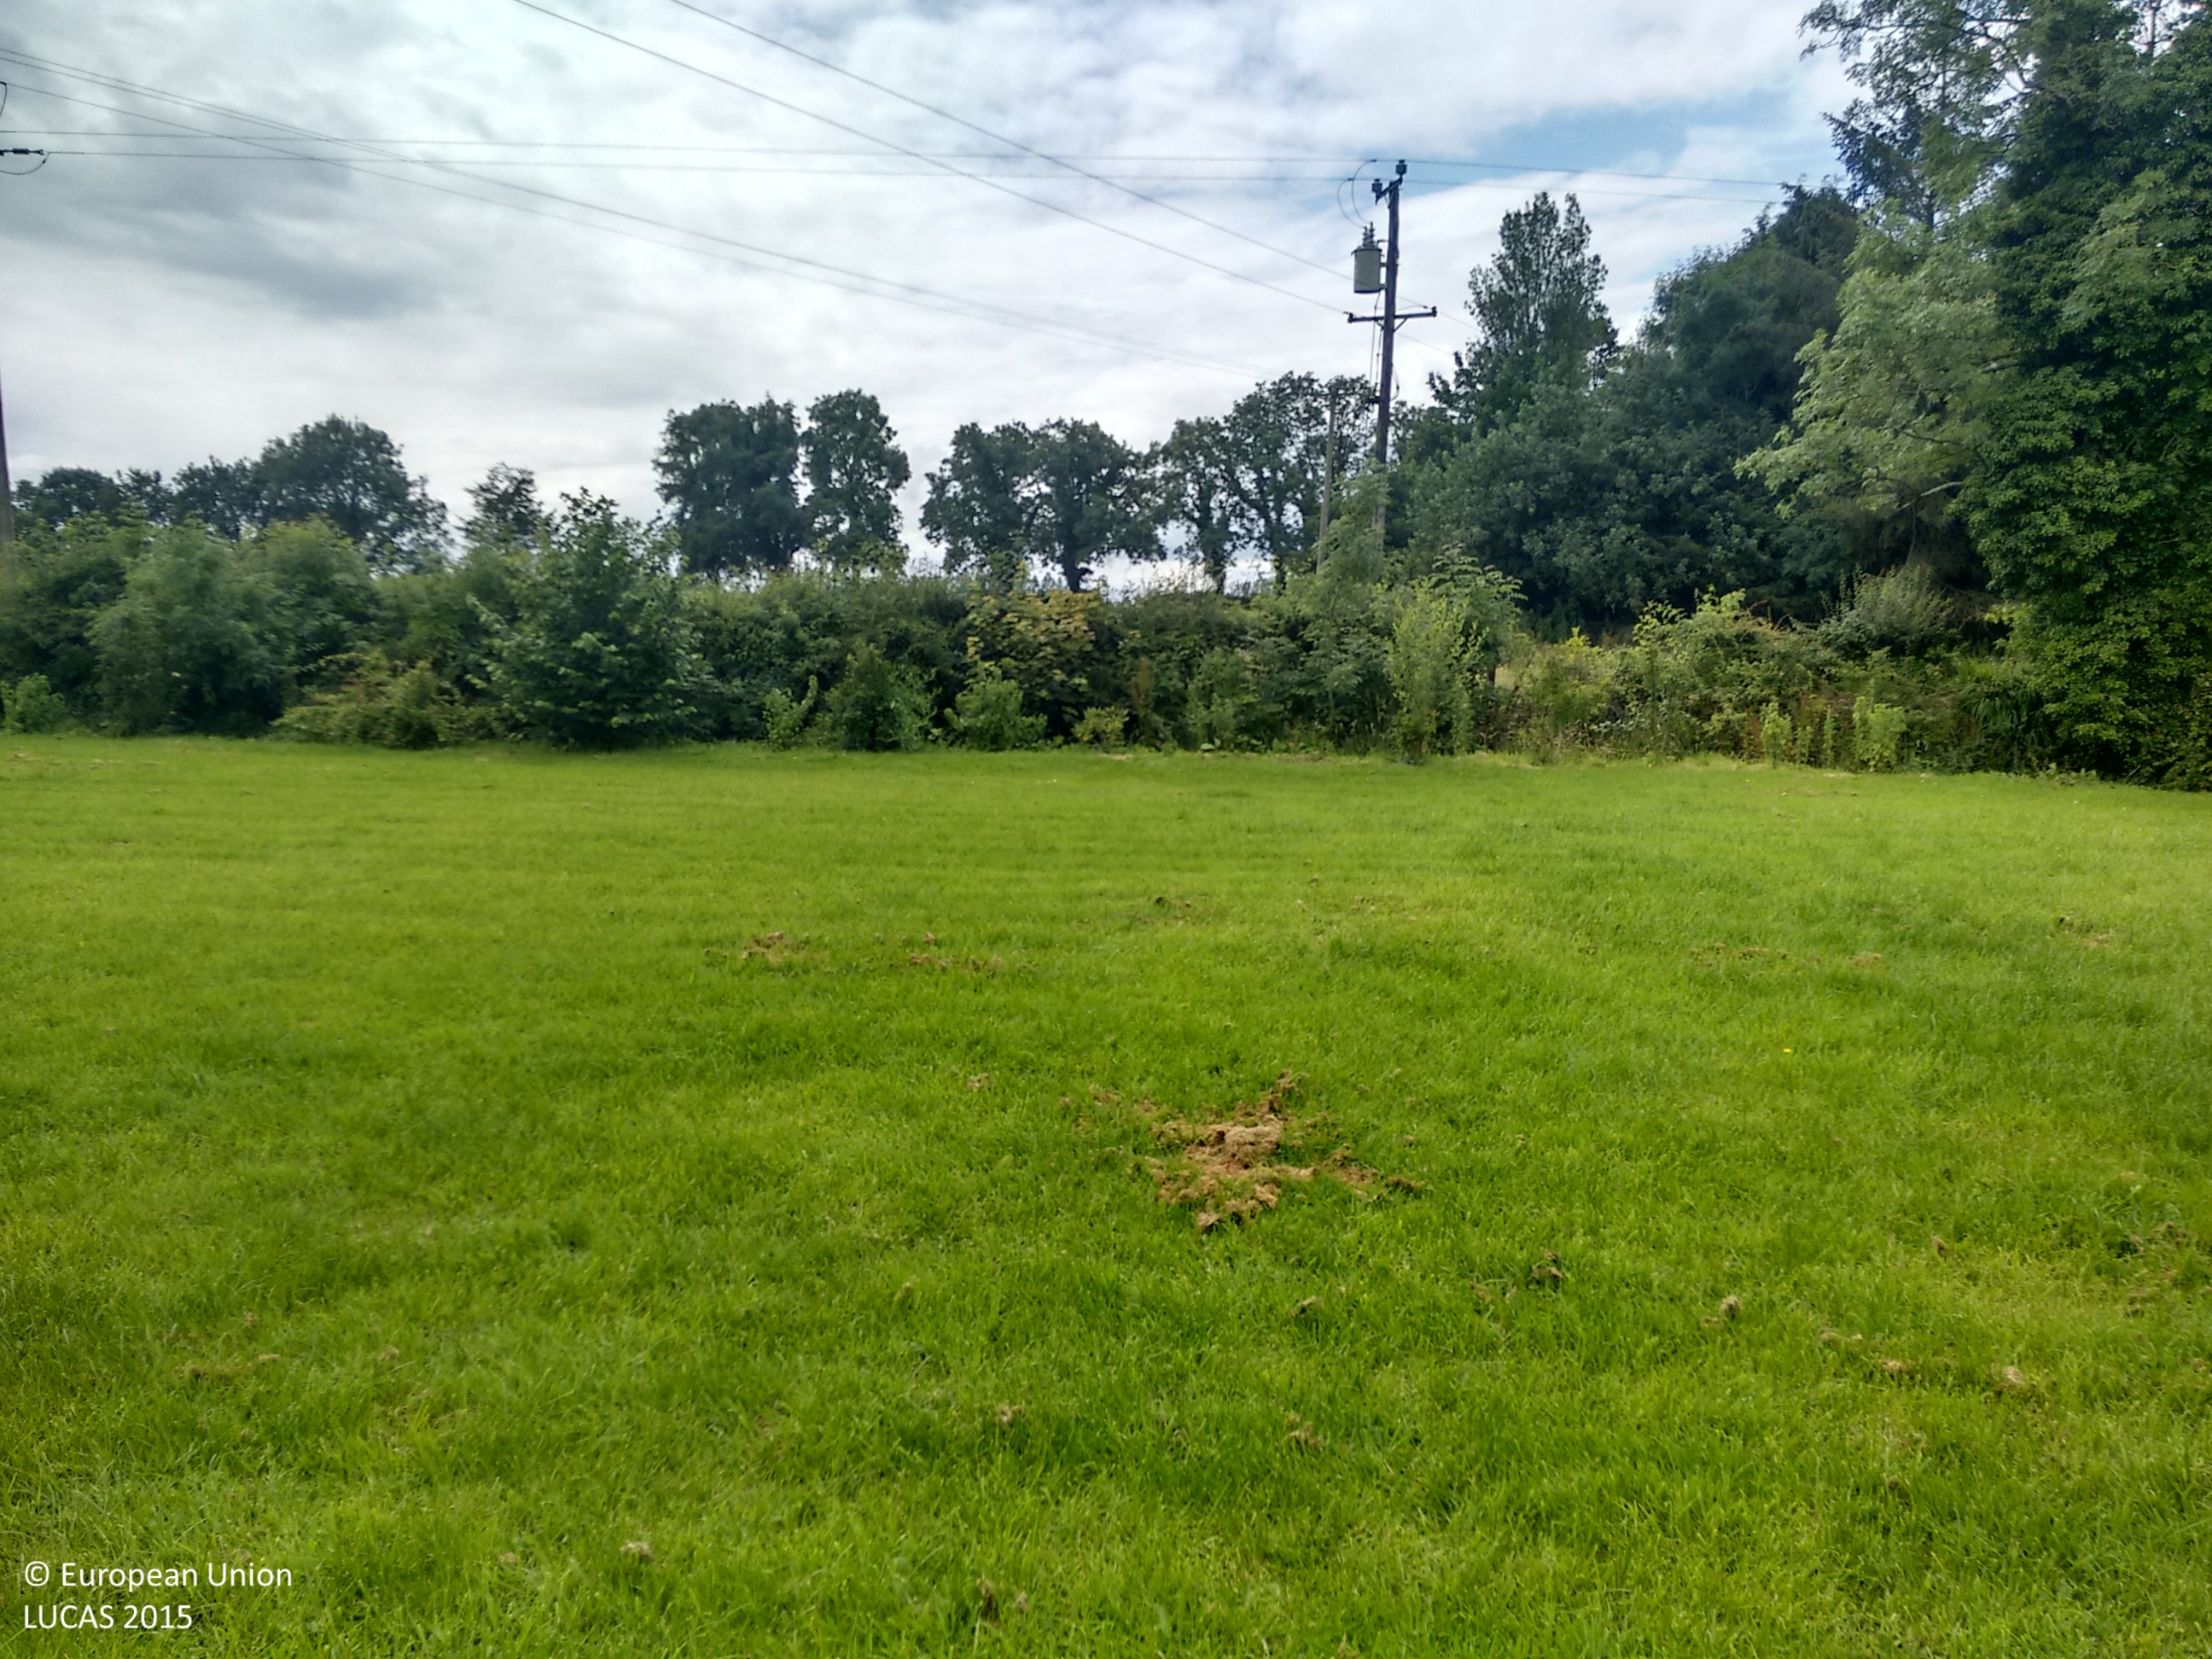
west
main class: Grassland
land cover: Grassland without tree/shrub cover
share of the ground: > 75 %
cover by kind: herbaceous plants 95 %, shrubs 5 %
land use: Residential
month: July
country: IE
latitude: 53.7324
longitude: -7.7656
